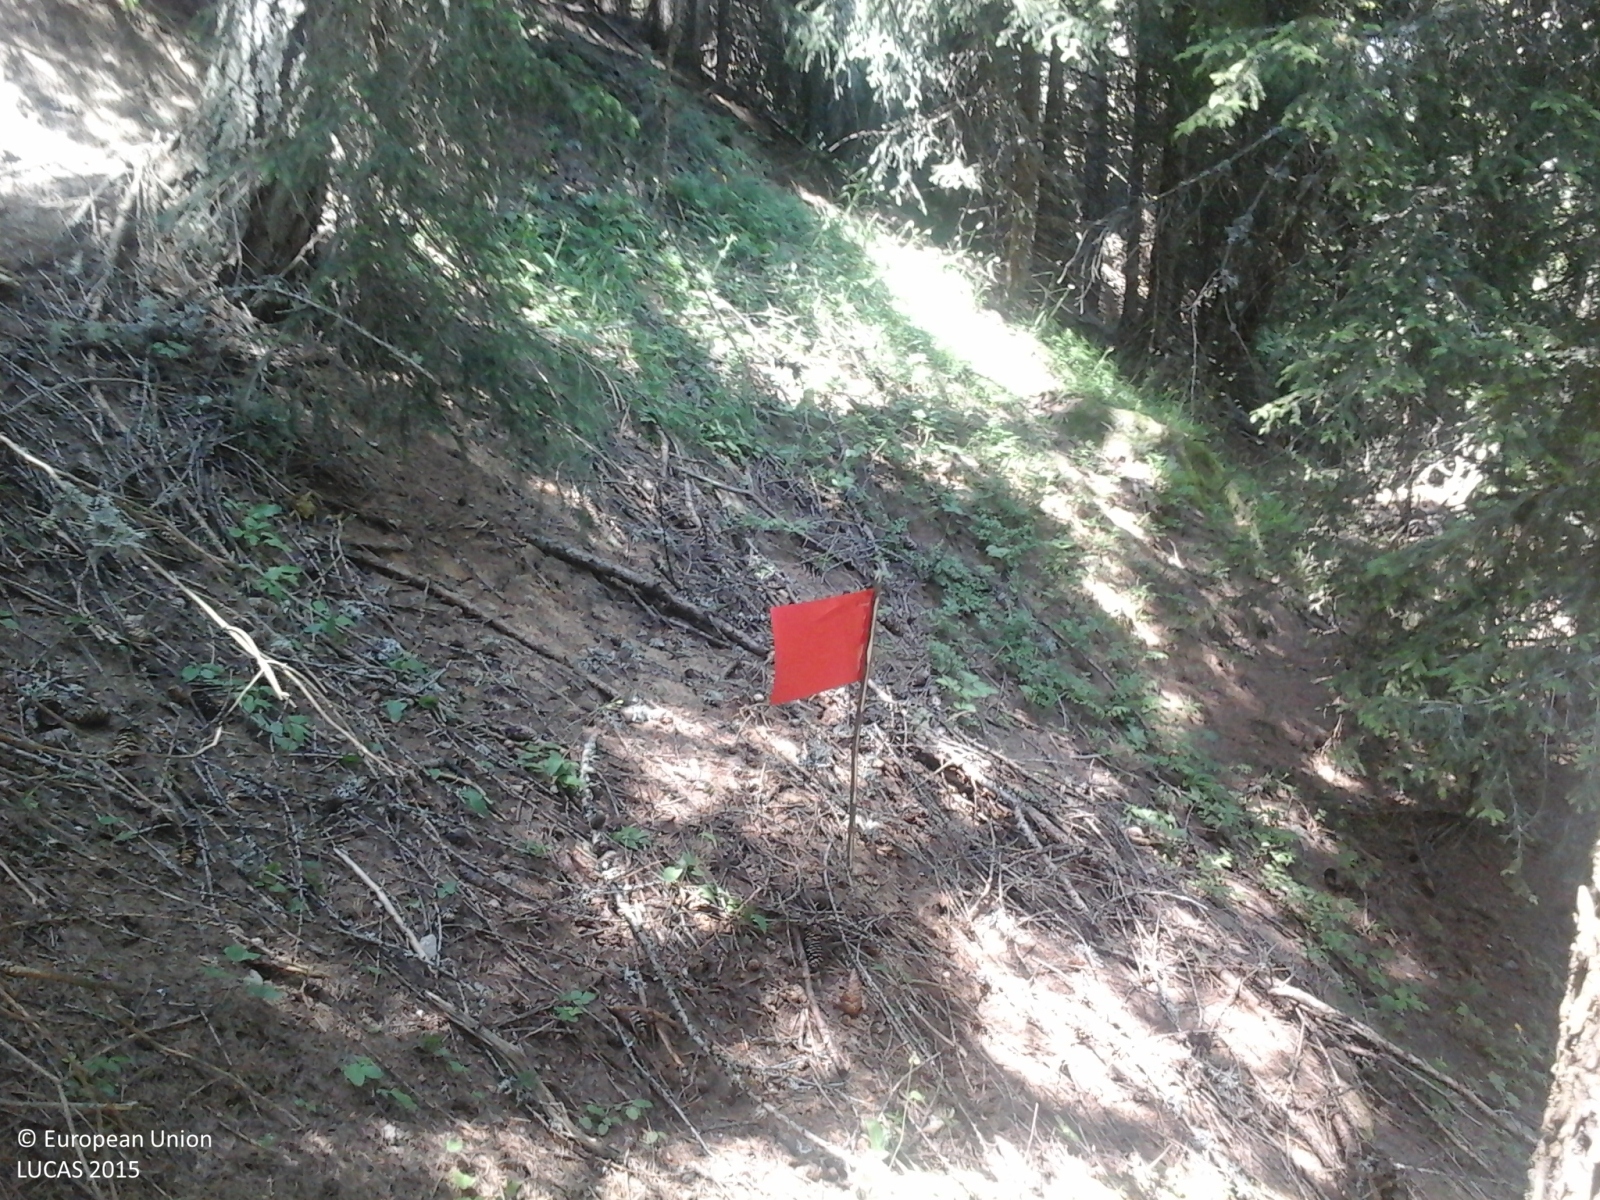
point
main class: Woodland
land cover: Other coniferous woodland
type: alpine coniferous forest
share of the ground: > 75 %
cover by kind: coniferous forest trees 100 %
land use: Forestry
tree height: > 5 m
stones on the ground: < 10 %
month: July
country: IT
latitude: 45.8033
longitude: 7.6743
